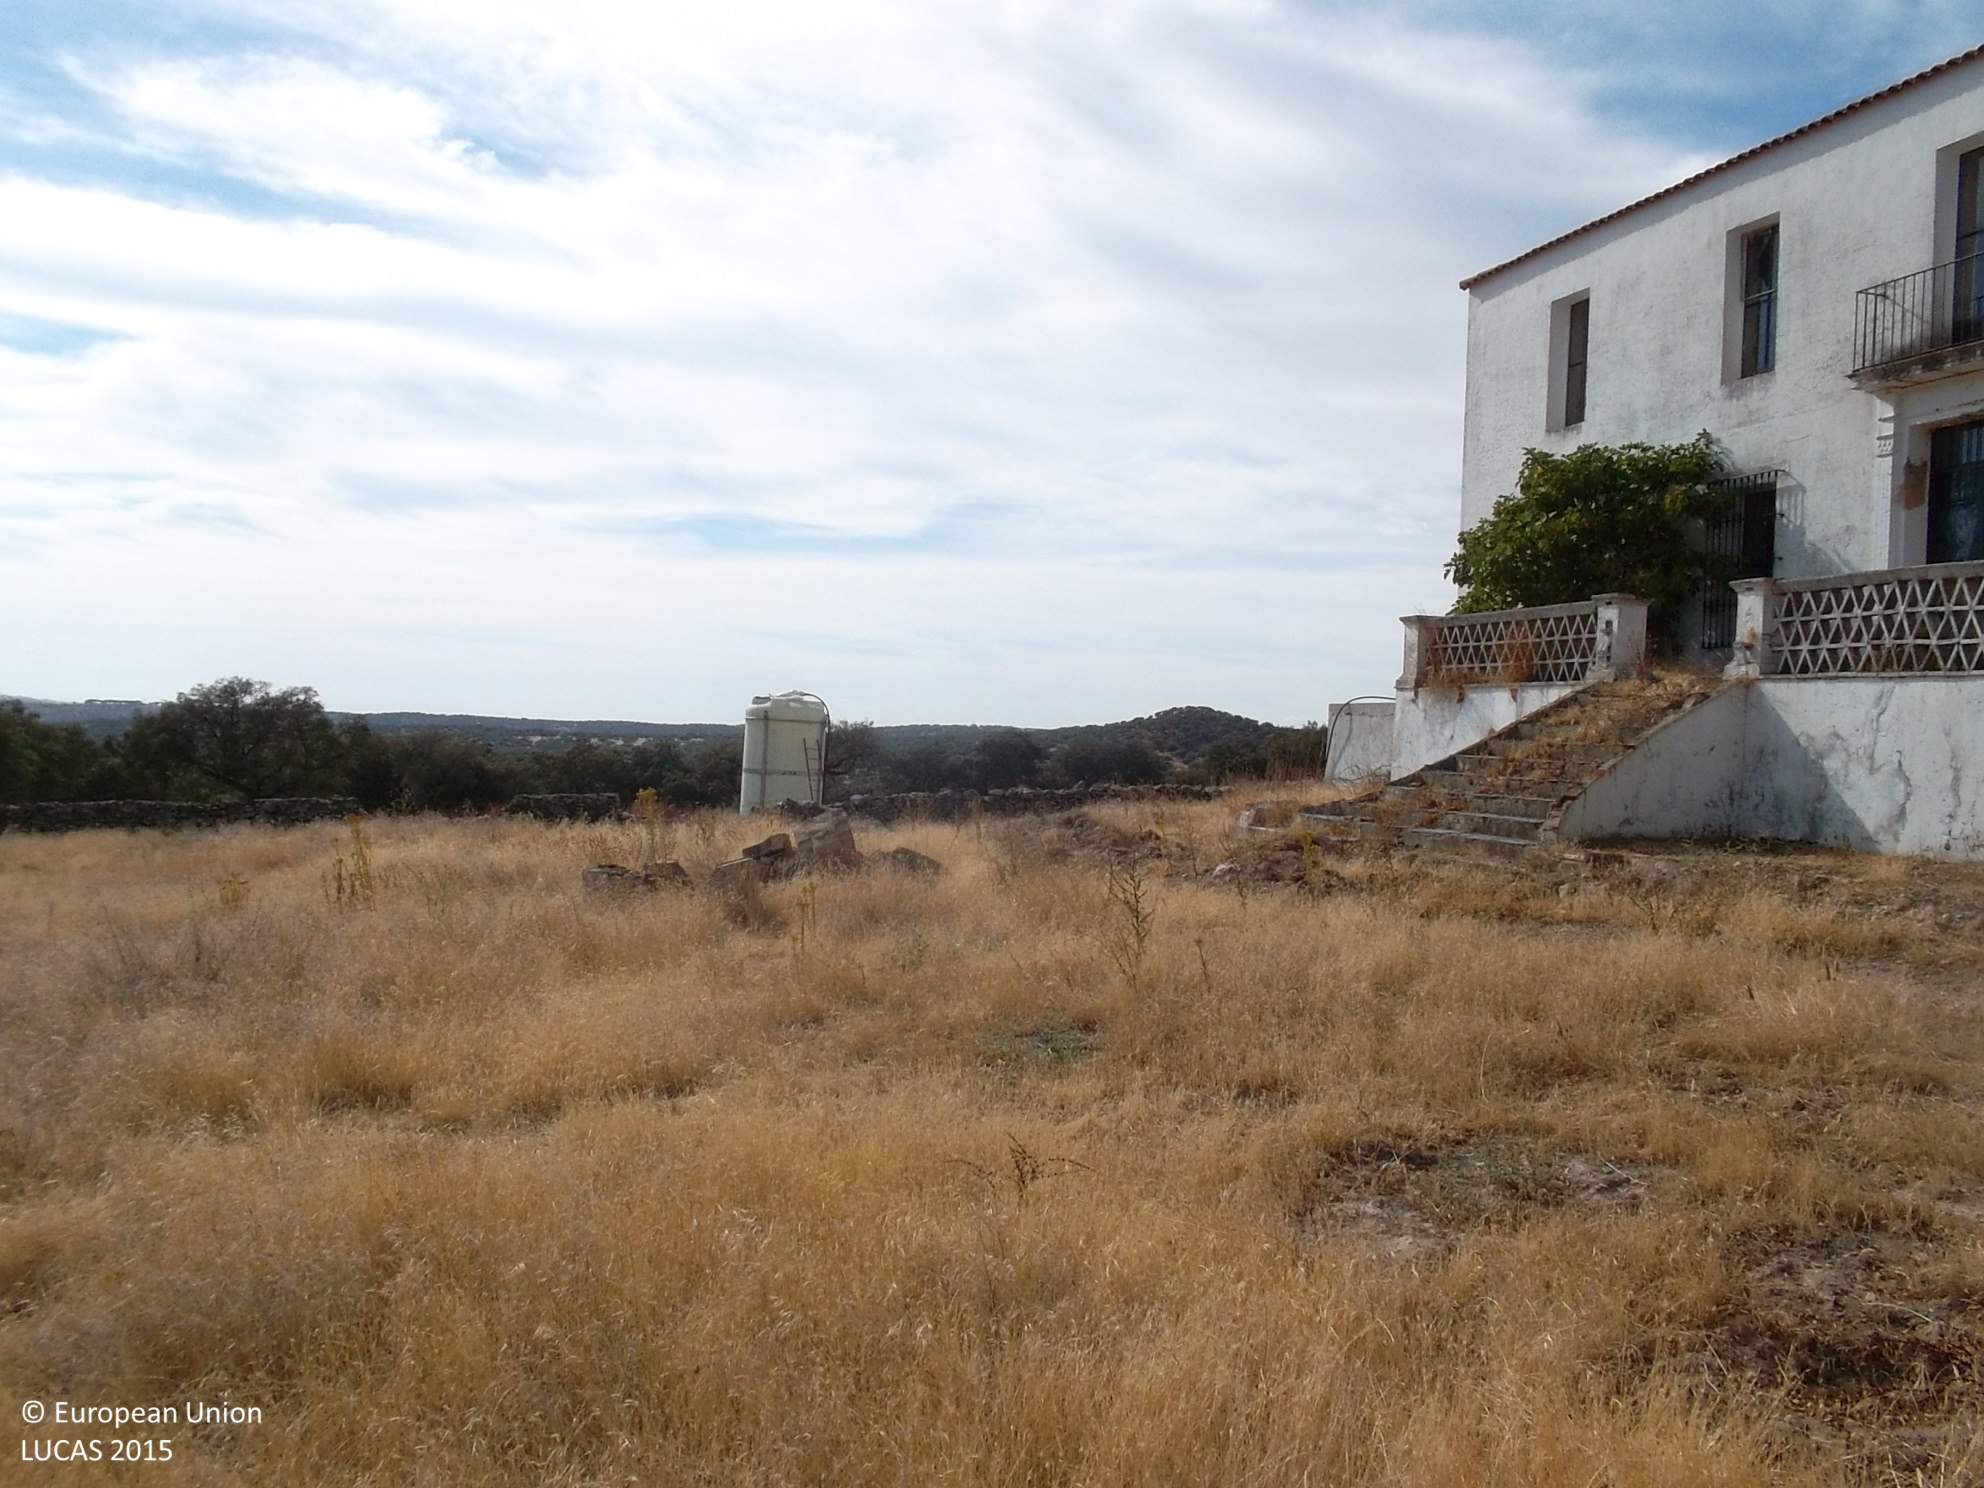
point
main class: Grassland
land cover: Grassland without tree/shrub cover
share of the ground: > 75 %
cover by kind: herbaceous plants 100 %
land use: Agriculture (excluding fallow land and kitchen gardens)
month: August
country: ES
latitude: 38.1444
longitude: -6.7916
